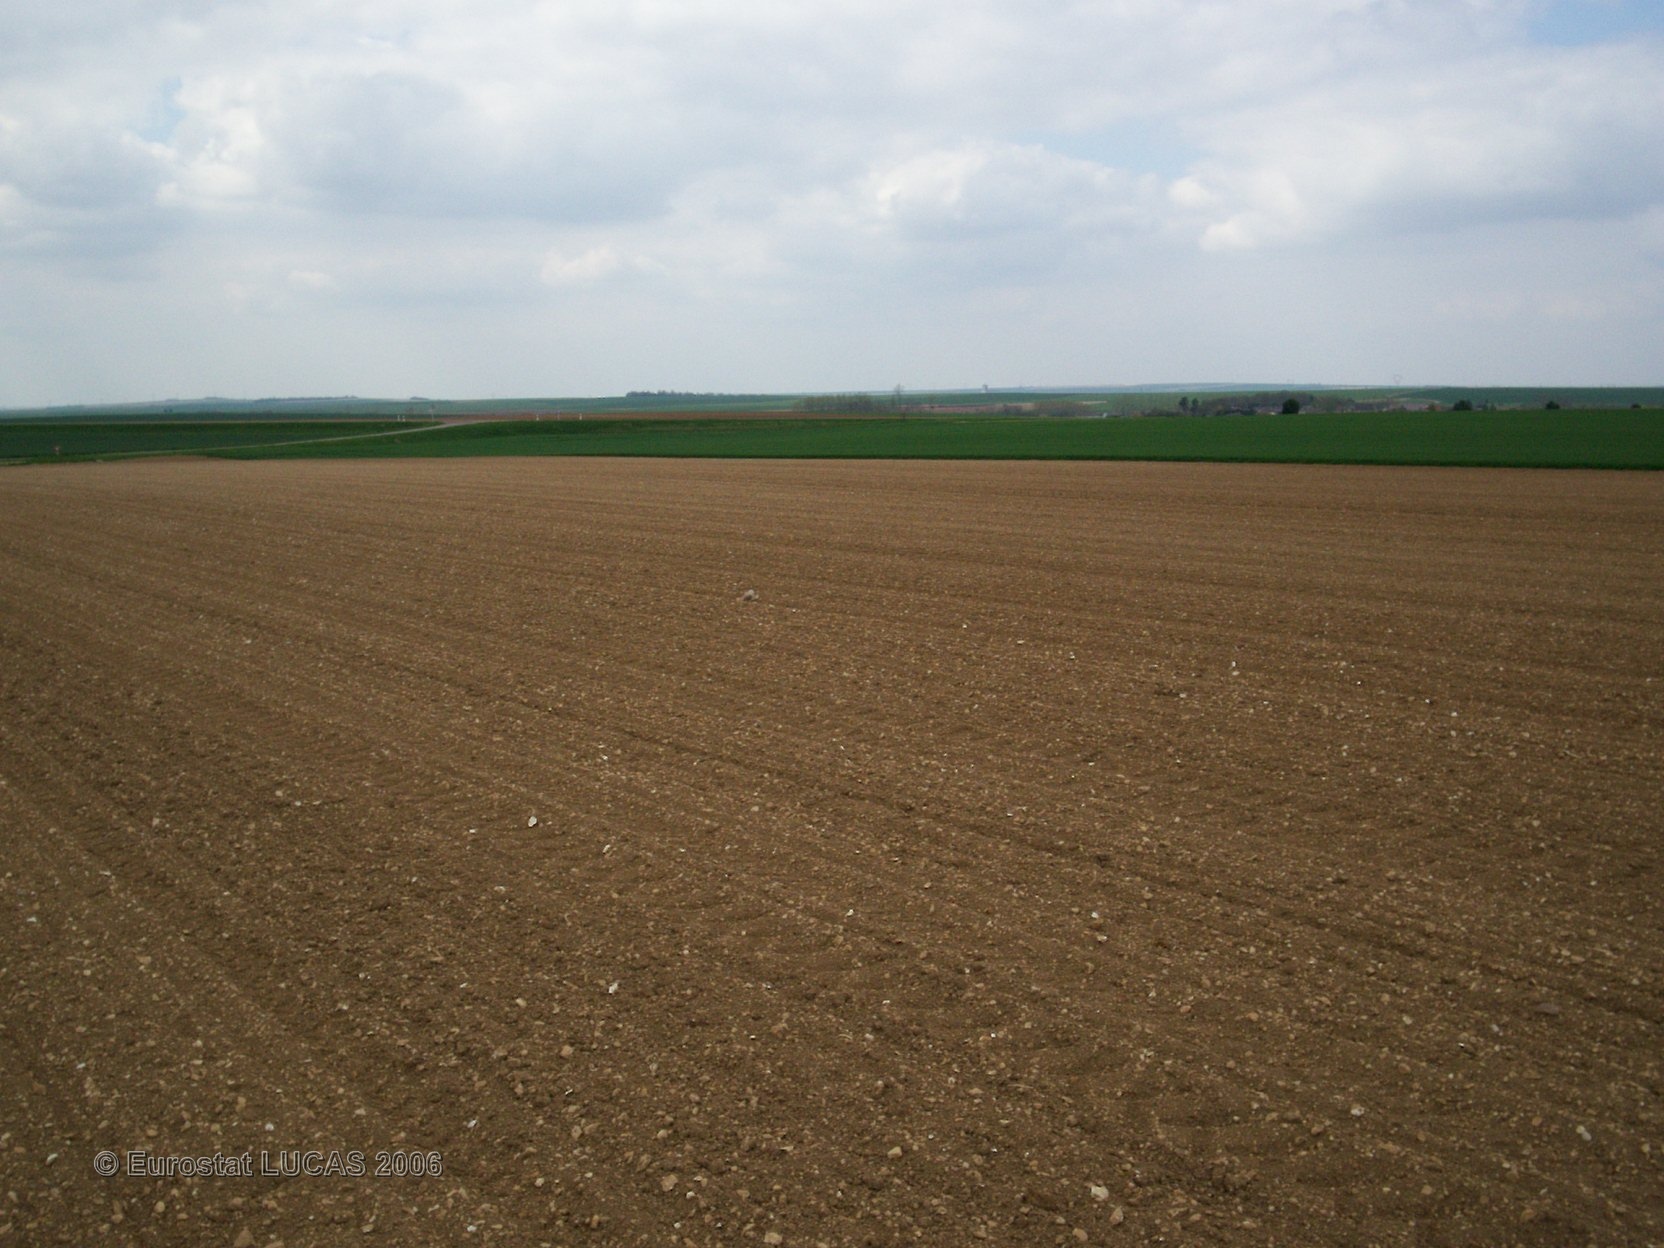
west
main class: Cropland
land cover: Sugar beet
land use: Agriculture (excluding fallow land and kitchen gardens)
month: April
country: FR
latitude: 48.5019
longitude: 4.5159
